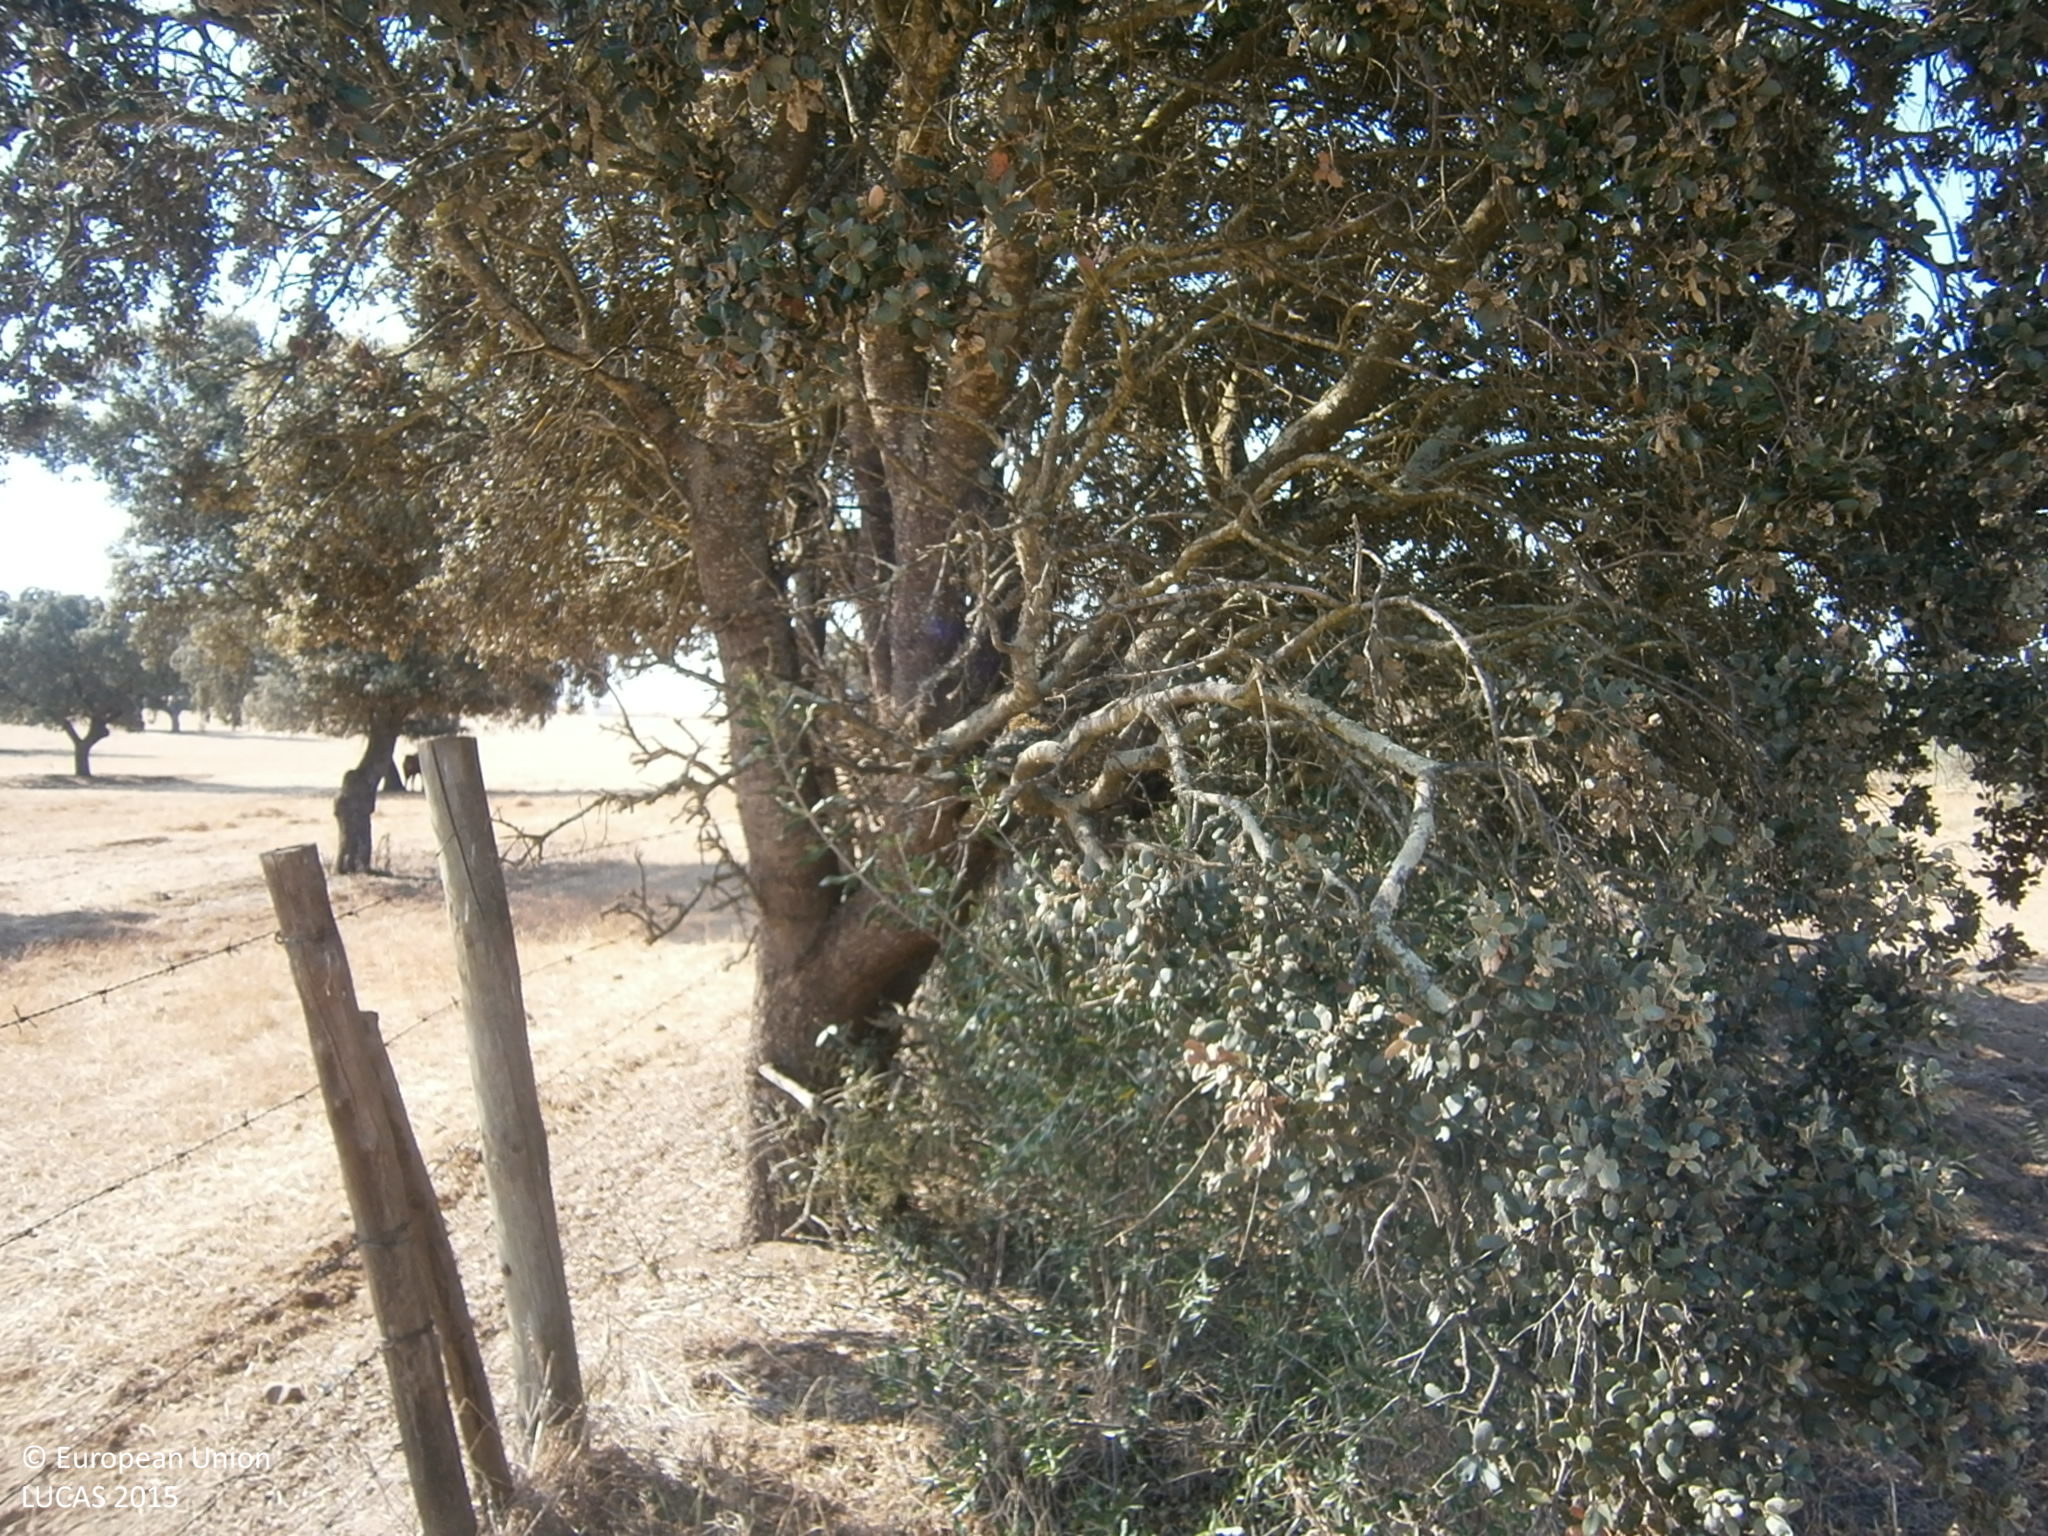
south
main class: Grassland
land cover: Grassland without tree/shrub cover
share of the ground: > 75 %
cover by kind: herbaceous plants 95 %, shrubs 5 %
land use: Agriculture (excluding fallow land and kitchen gardens)
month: June
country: ES
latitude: 38.8154
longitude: -6.7519
